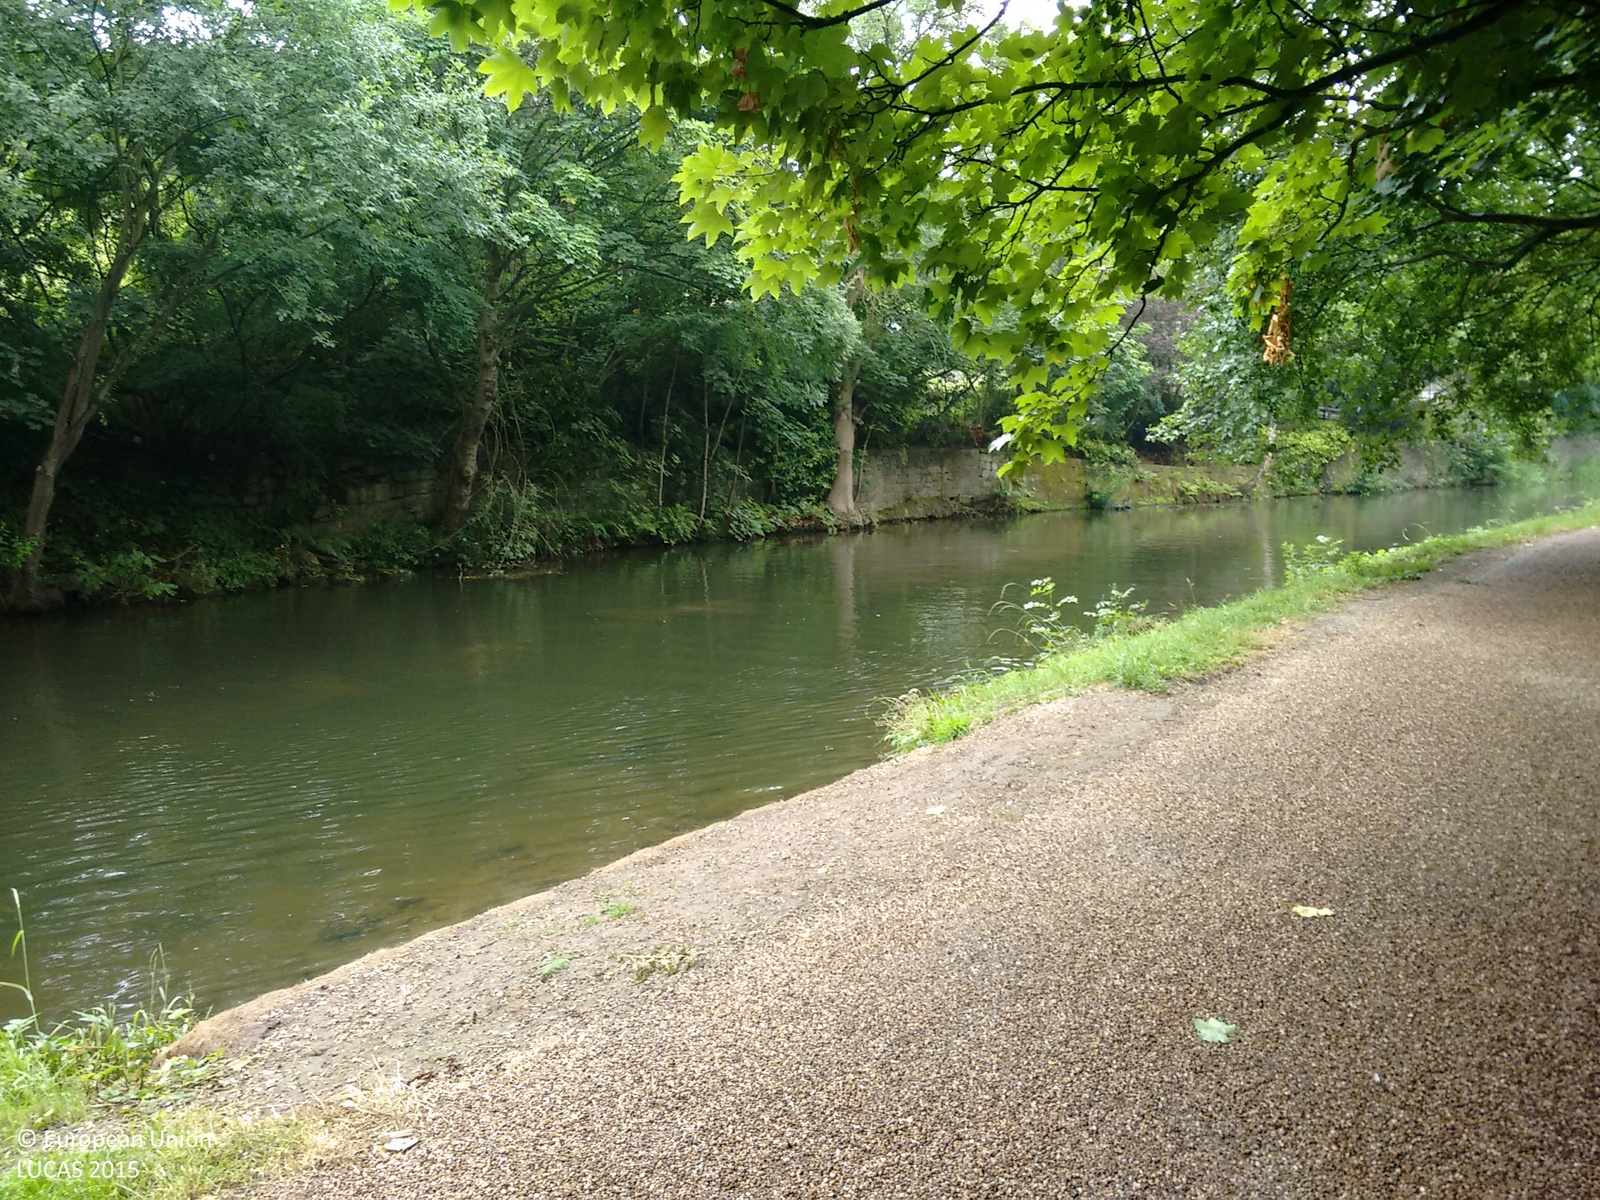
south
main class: Woodland
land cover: Broadleaved woodland
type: mesophytic deciduous forest
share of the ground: > 75 %
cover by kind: broadleaved forest trees 100 %
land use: Semi-natural and natural areas not in use
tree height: > 5 m
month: July
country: GB
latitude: 53.8196
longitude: -1.6416
